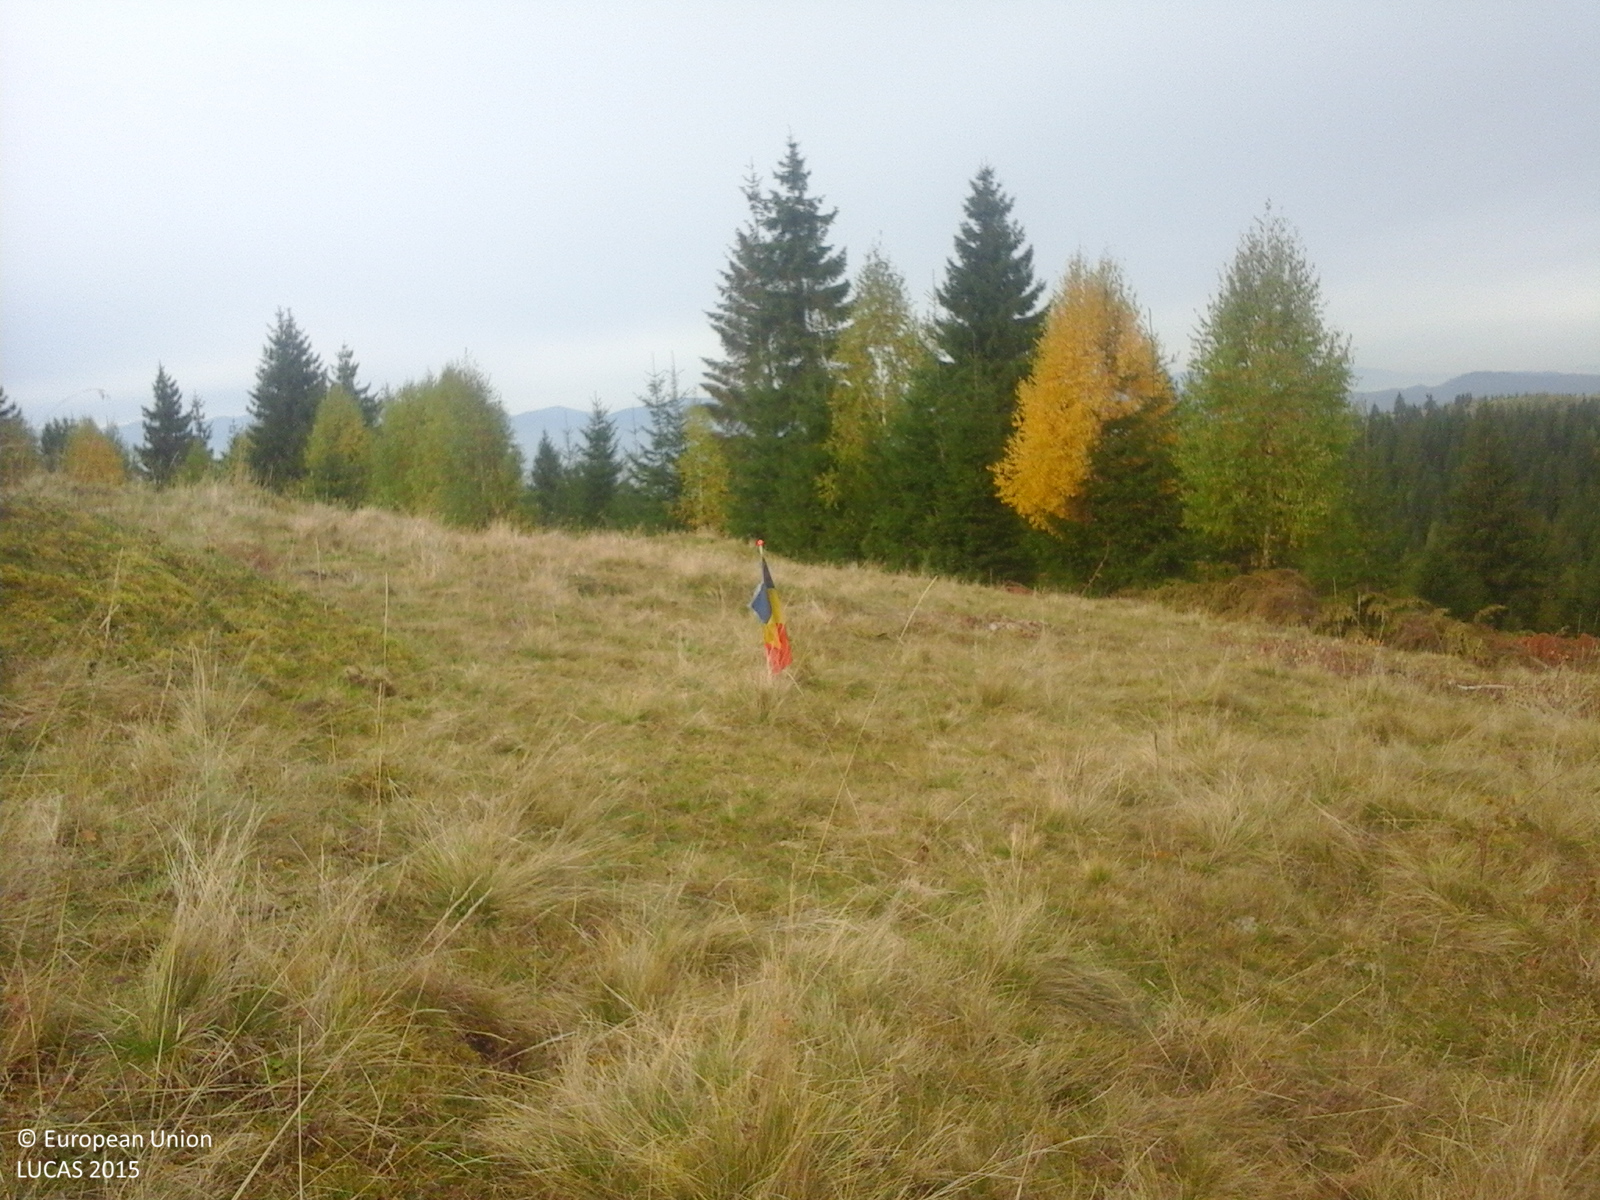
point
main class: Grassland
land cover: Grassland without tree/shrub cover
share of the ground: > 75 %
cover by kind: herbaceous plants 100 %
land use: Agriculture (excluding fallow land and kitchen gardens)
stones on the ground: < 10 %
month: October
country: RO
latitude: 46.5697
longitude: 25.8659
